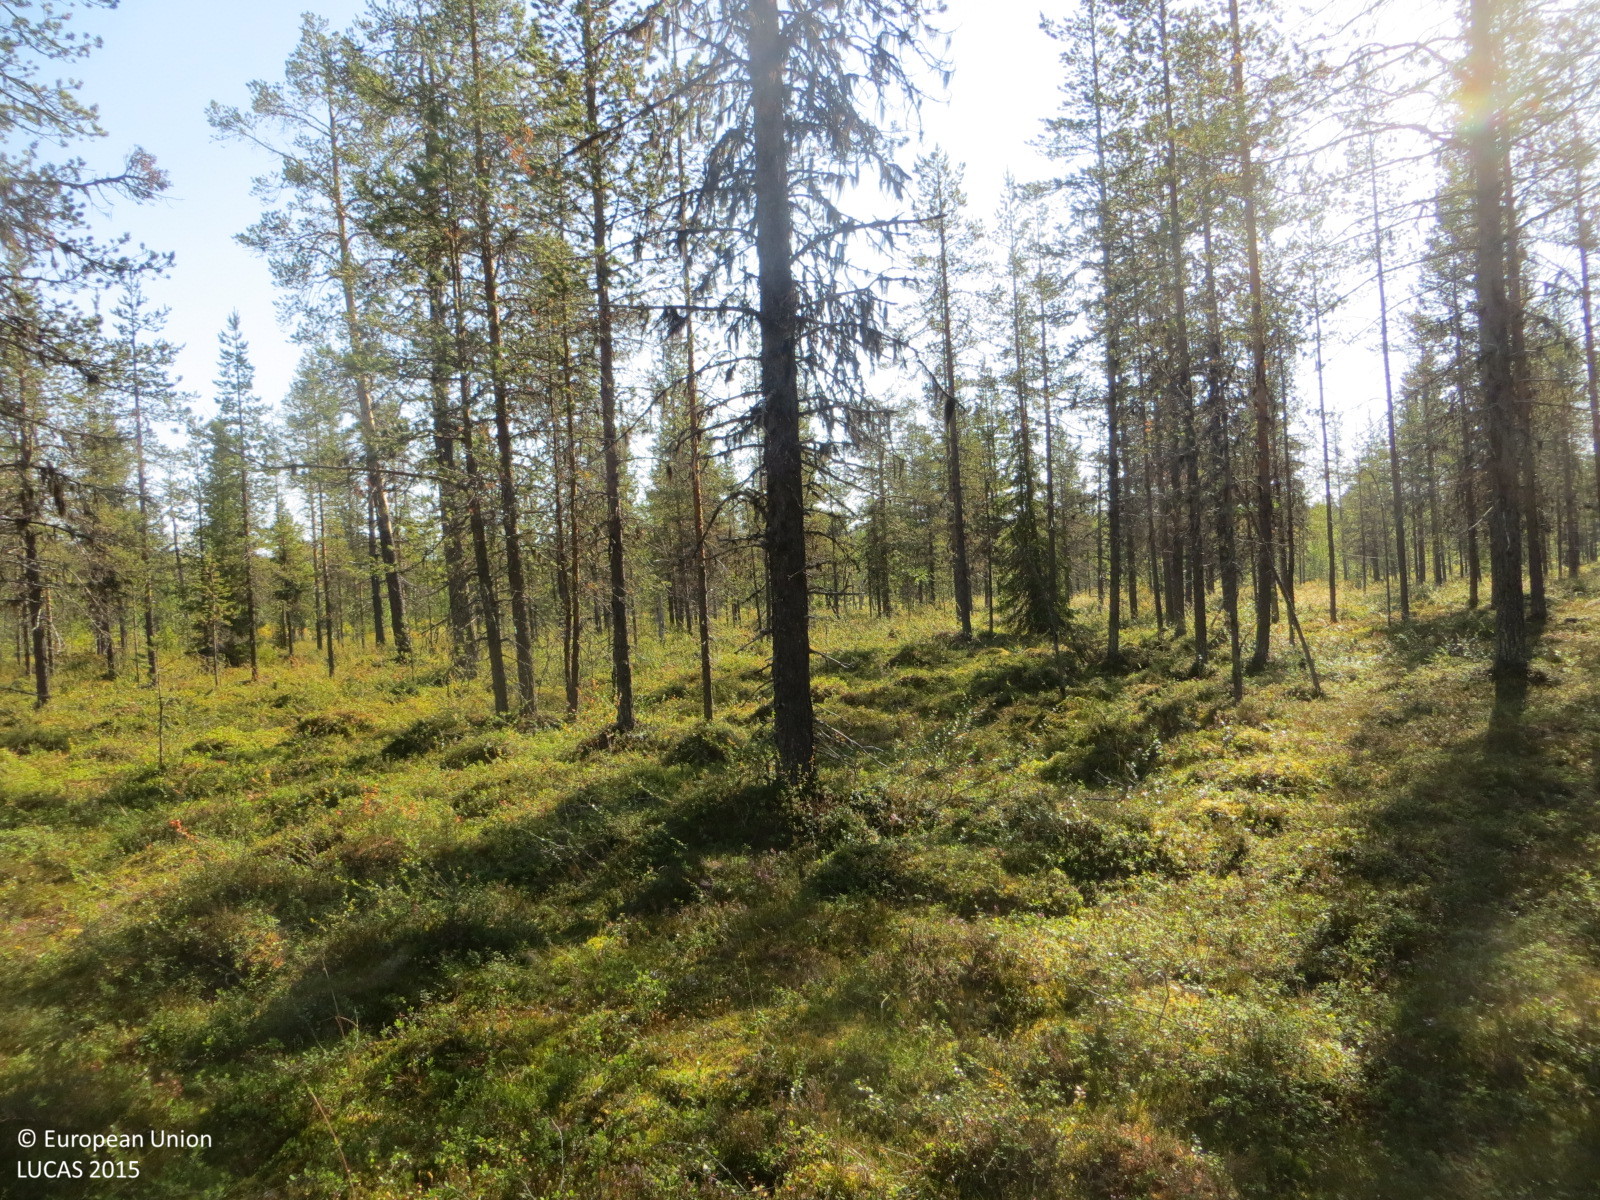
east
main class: Woodland
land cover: Pine dominated coniferous woodland
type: boreal forest
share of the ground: 50 - 75 %
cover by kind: coniferous forest trees 50 %, shrubs 50 %
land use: Forestry
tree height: > 5 m
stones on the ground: < 10 %
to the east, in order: Pine dominated coniferous woodland; Shrubland with sparse tree cover; Broadleaved woodland; Rivers and streams; Broadleaved woodland; Pine dominated coniferous woodland
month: August
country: FI
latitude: 67.7104
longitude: 24.1264
